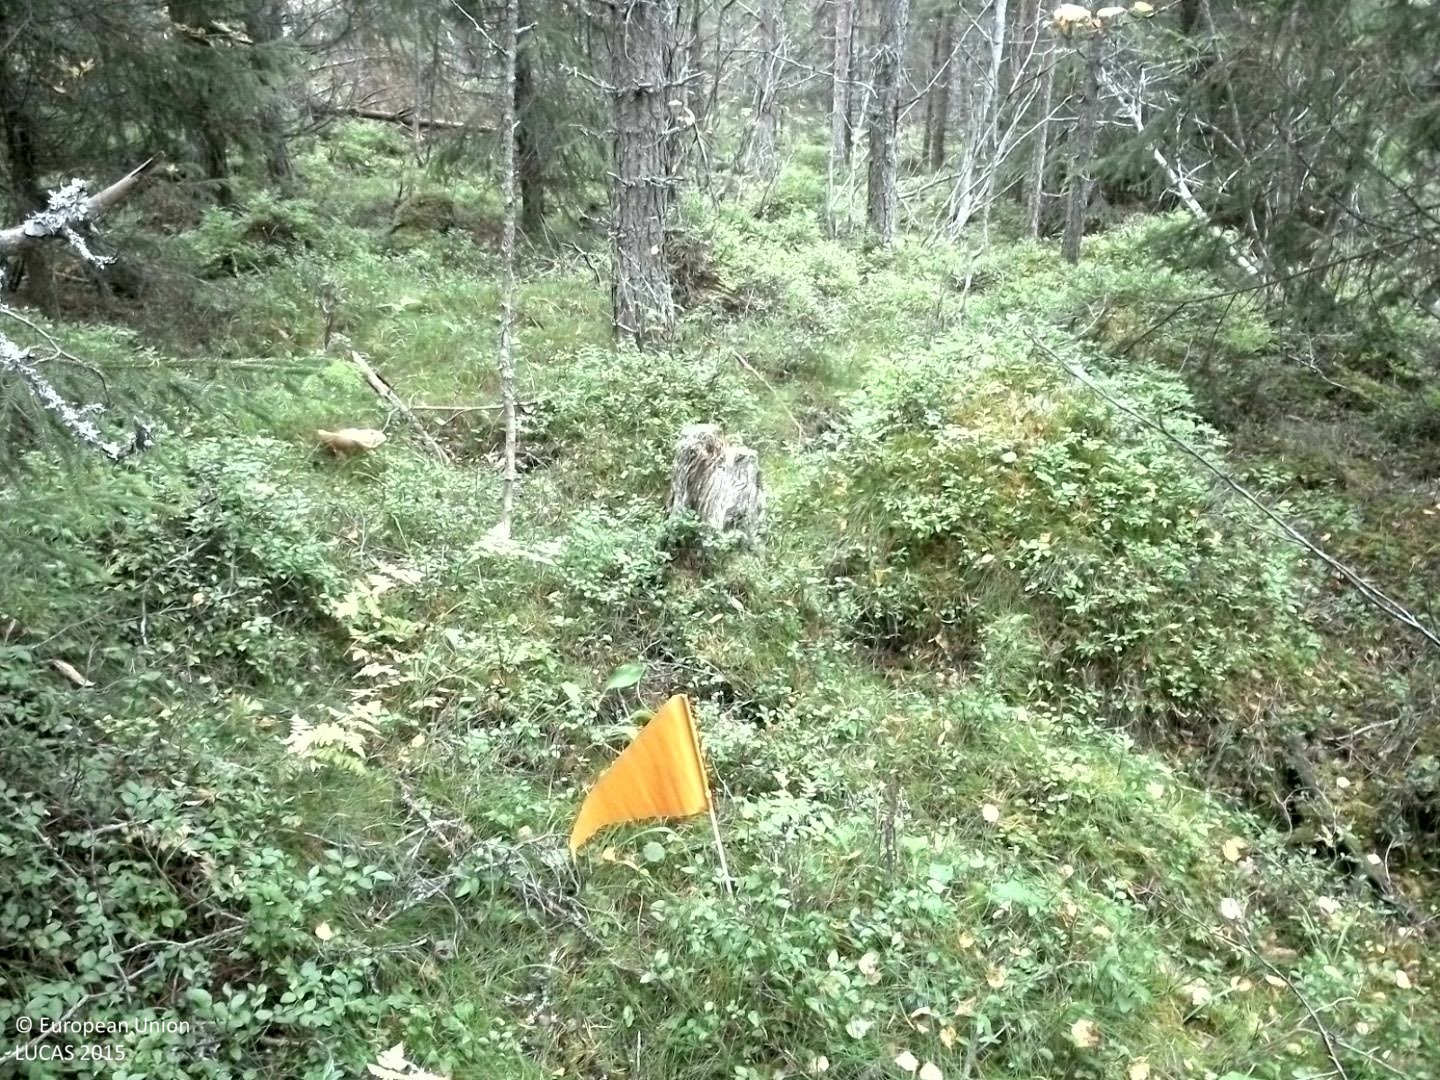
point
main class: Woodland
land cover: Other mixed woodland
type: boreal forest
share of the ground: 50 - 75 %
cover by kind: coniferous forest trees 45 %, herbaceous plants 25 %, broadleaved forest trees 20 %, shrubs 10 %
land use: Forestry
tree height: > 5 m
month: September
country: SE
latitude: 62.3082
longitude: 15.6321
